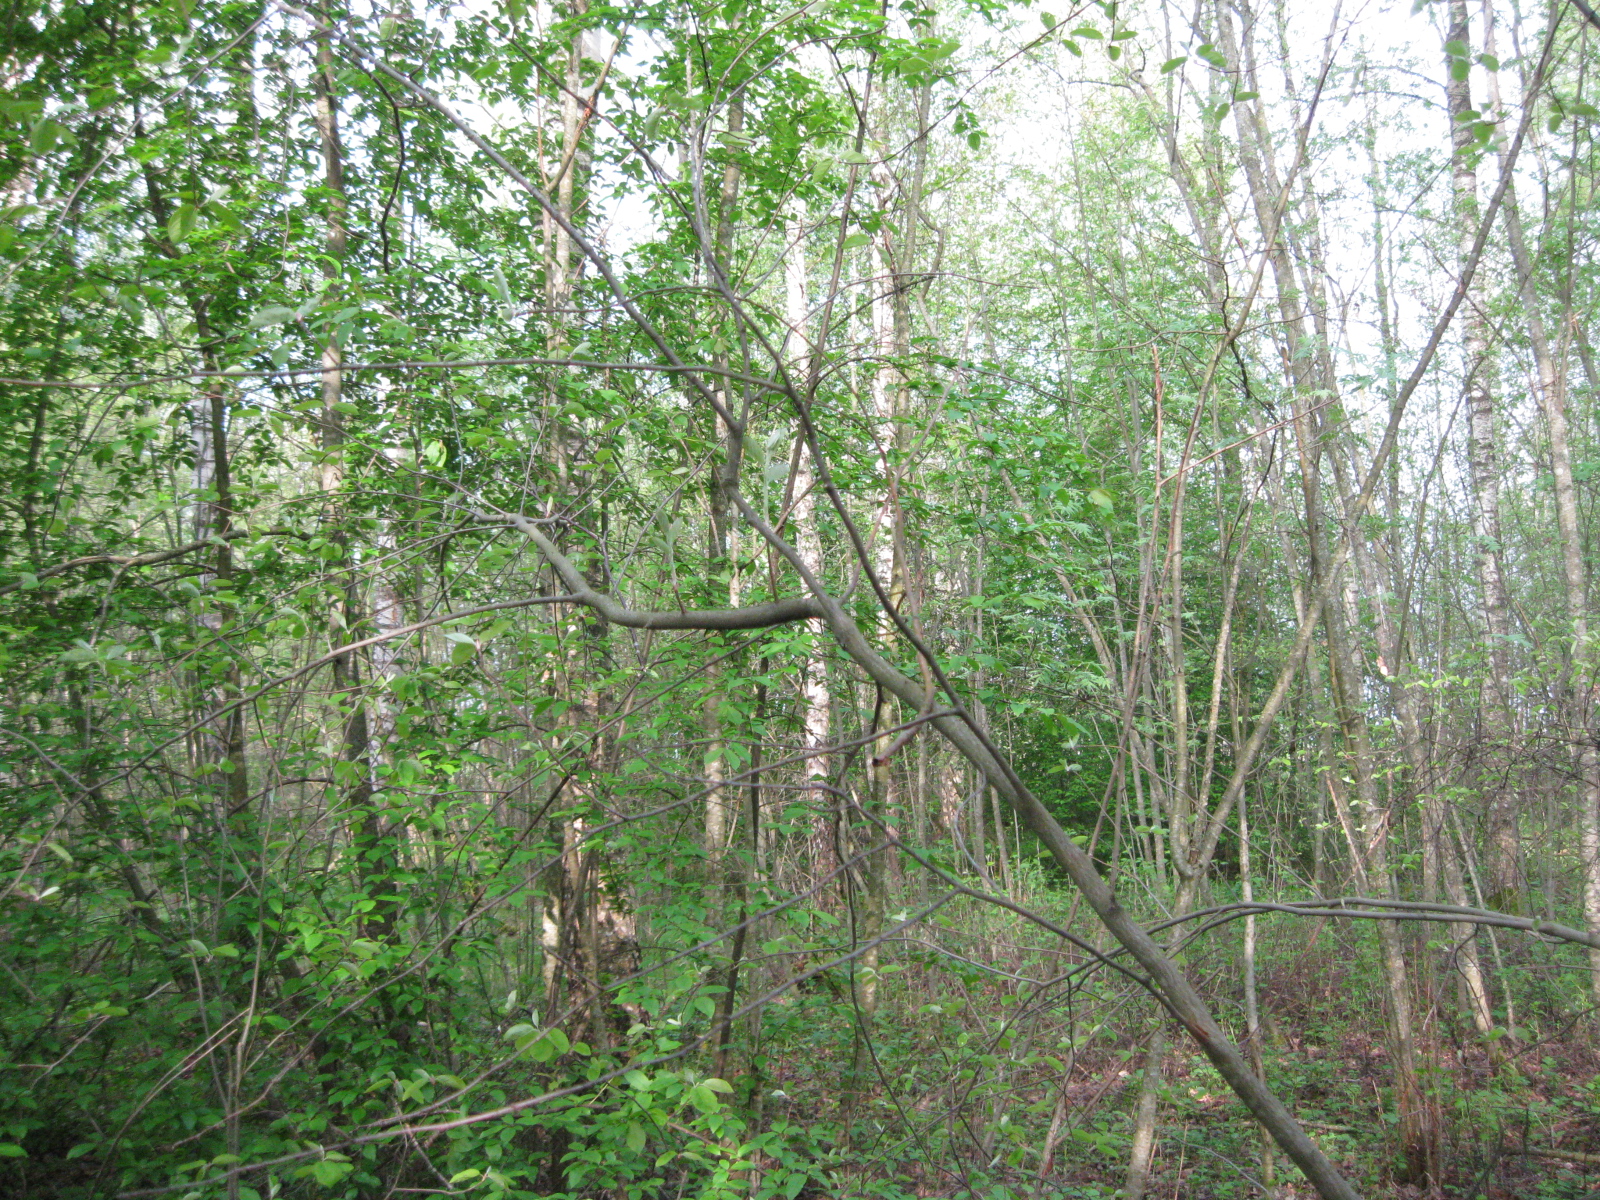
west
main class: Woodland
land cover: Broadleaved woodland
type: non-riverine alder, birch or aspen forest
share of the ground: > 75 %
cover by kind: broadleaved forest trees 90 %, herbaceous plants 10 %
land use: Forestry
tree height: > 5 m
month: May
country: LT
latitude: 56.2397
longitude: 24.4727
